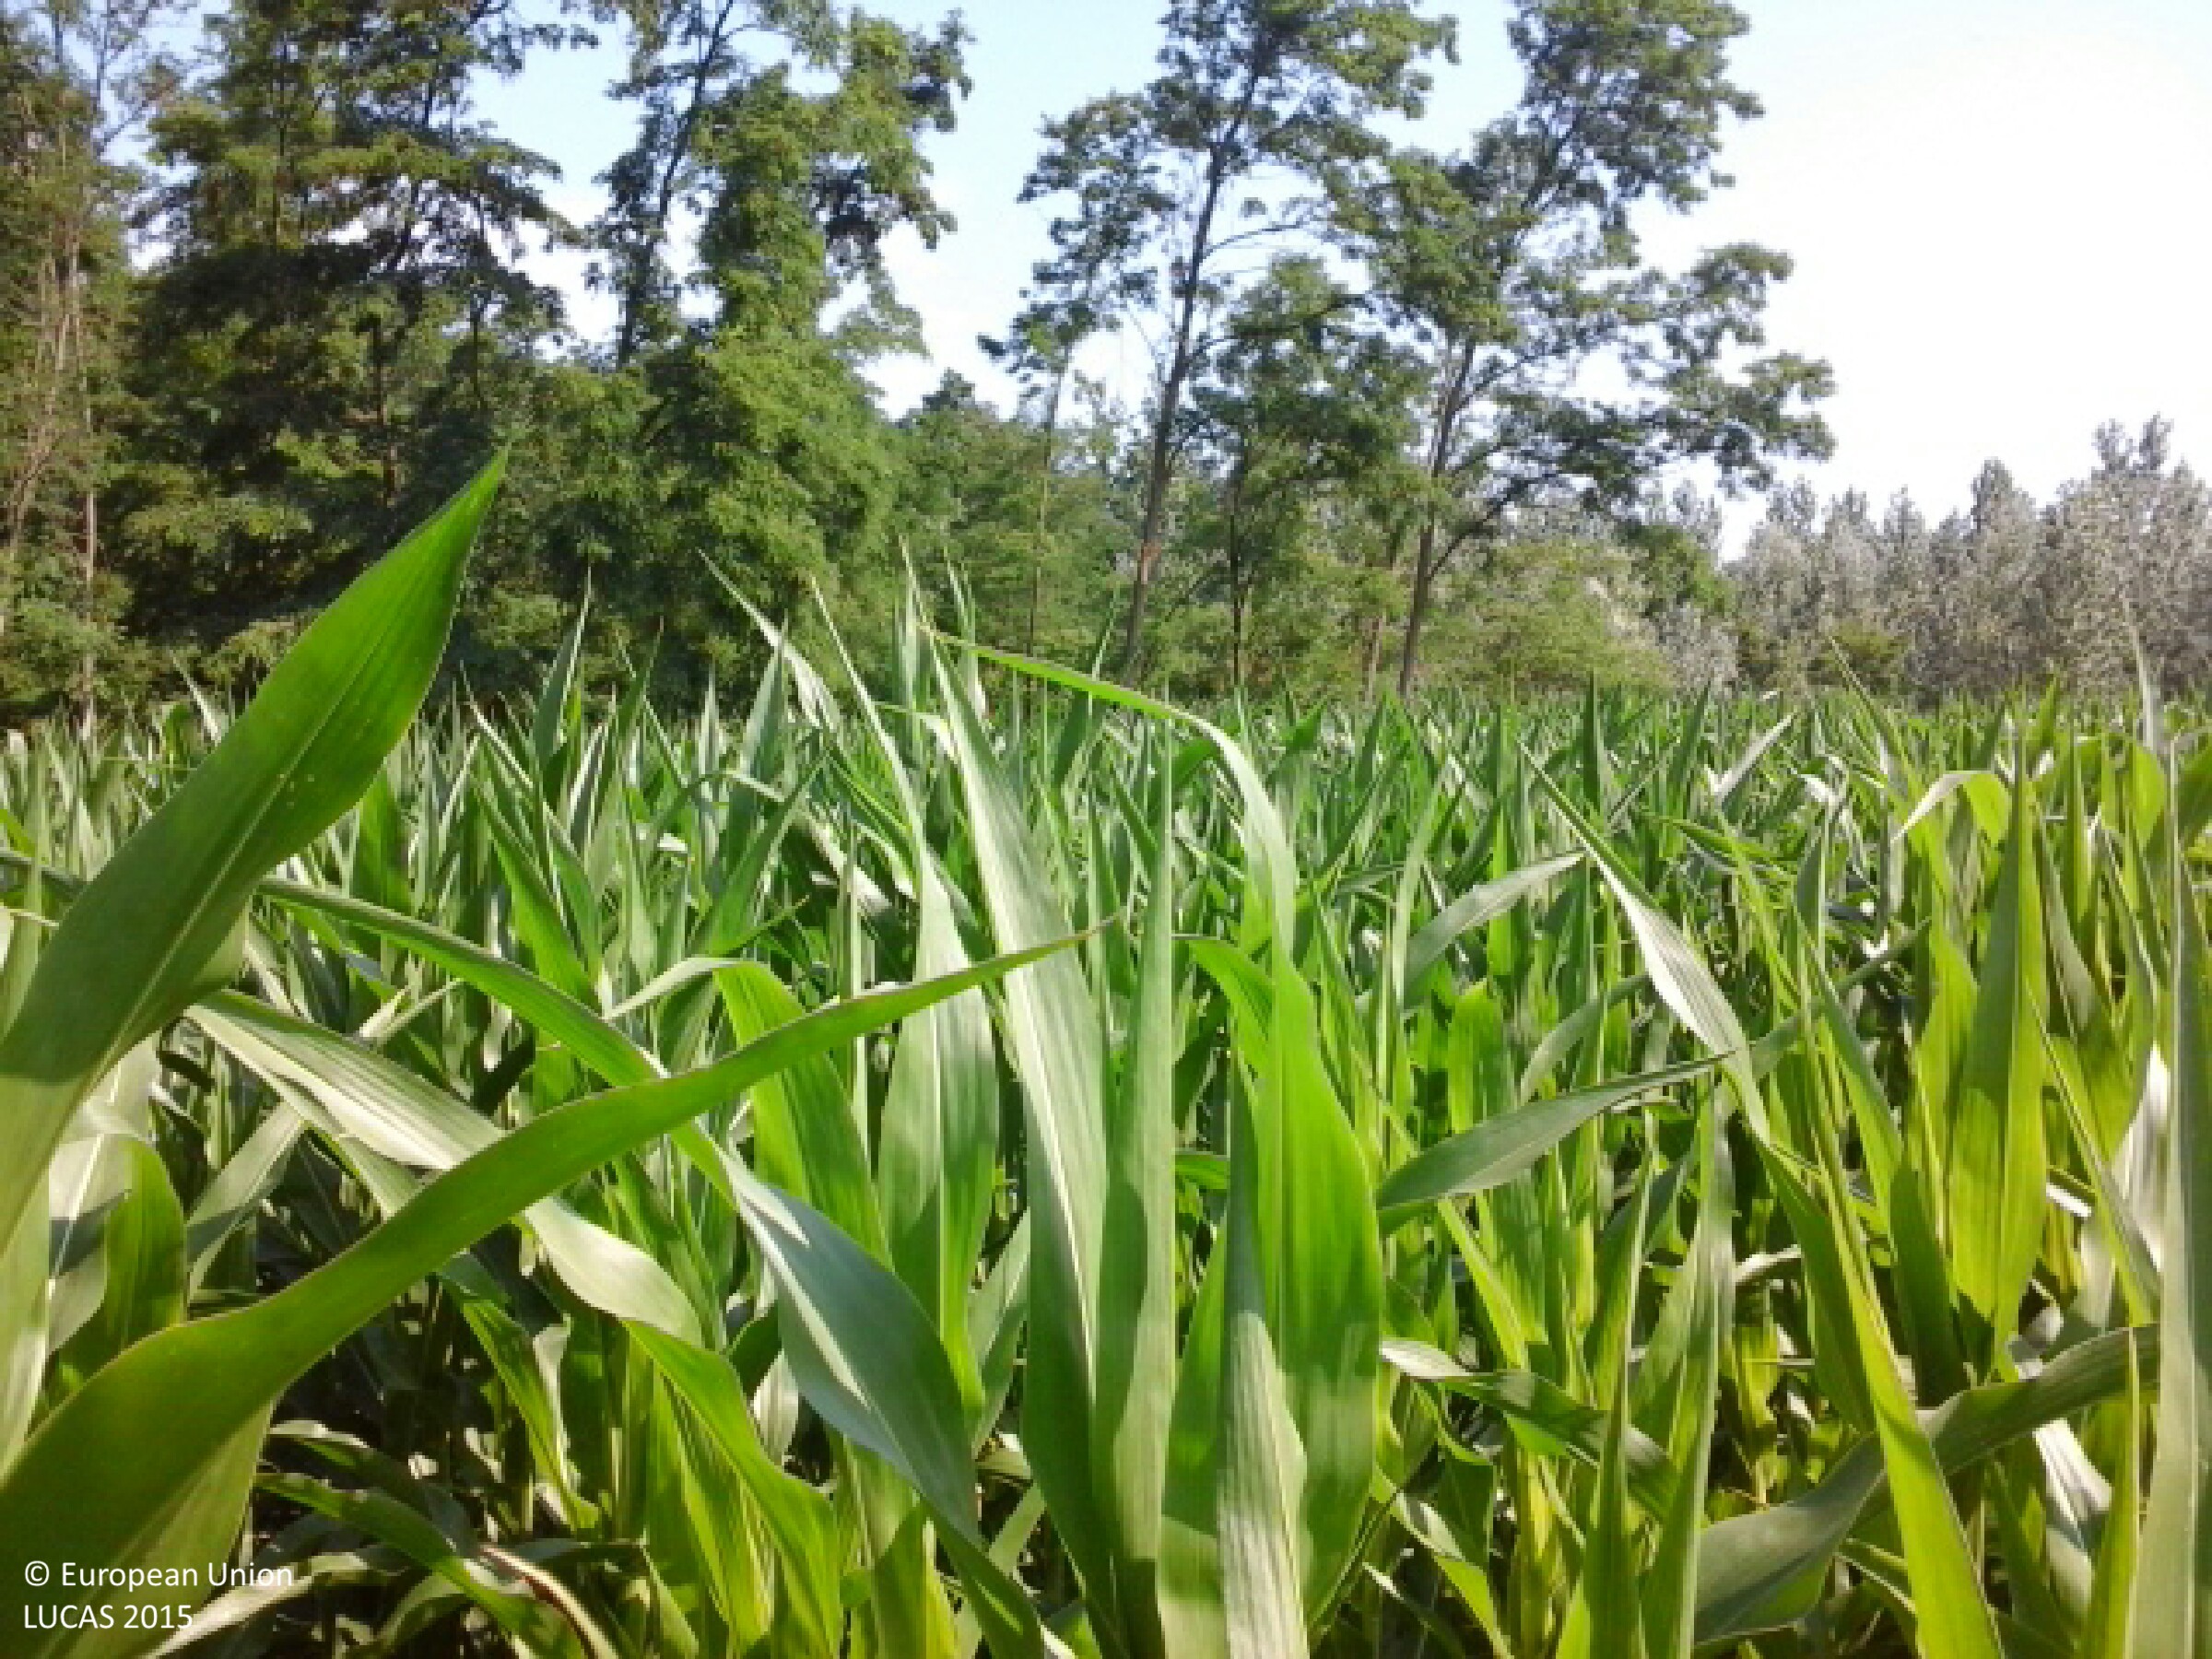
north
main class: Cropland
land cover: Maize
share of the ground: > 75 %
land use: Agriculture (excluding fallow land and kitchen gardens)
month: June
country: HU
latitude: 48.2058
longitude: 21.7972
